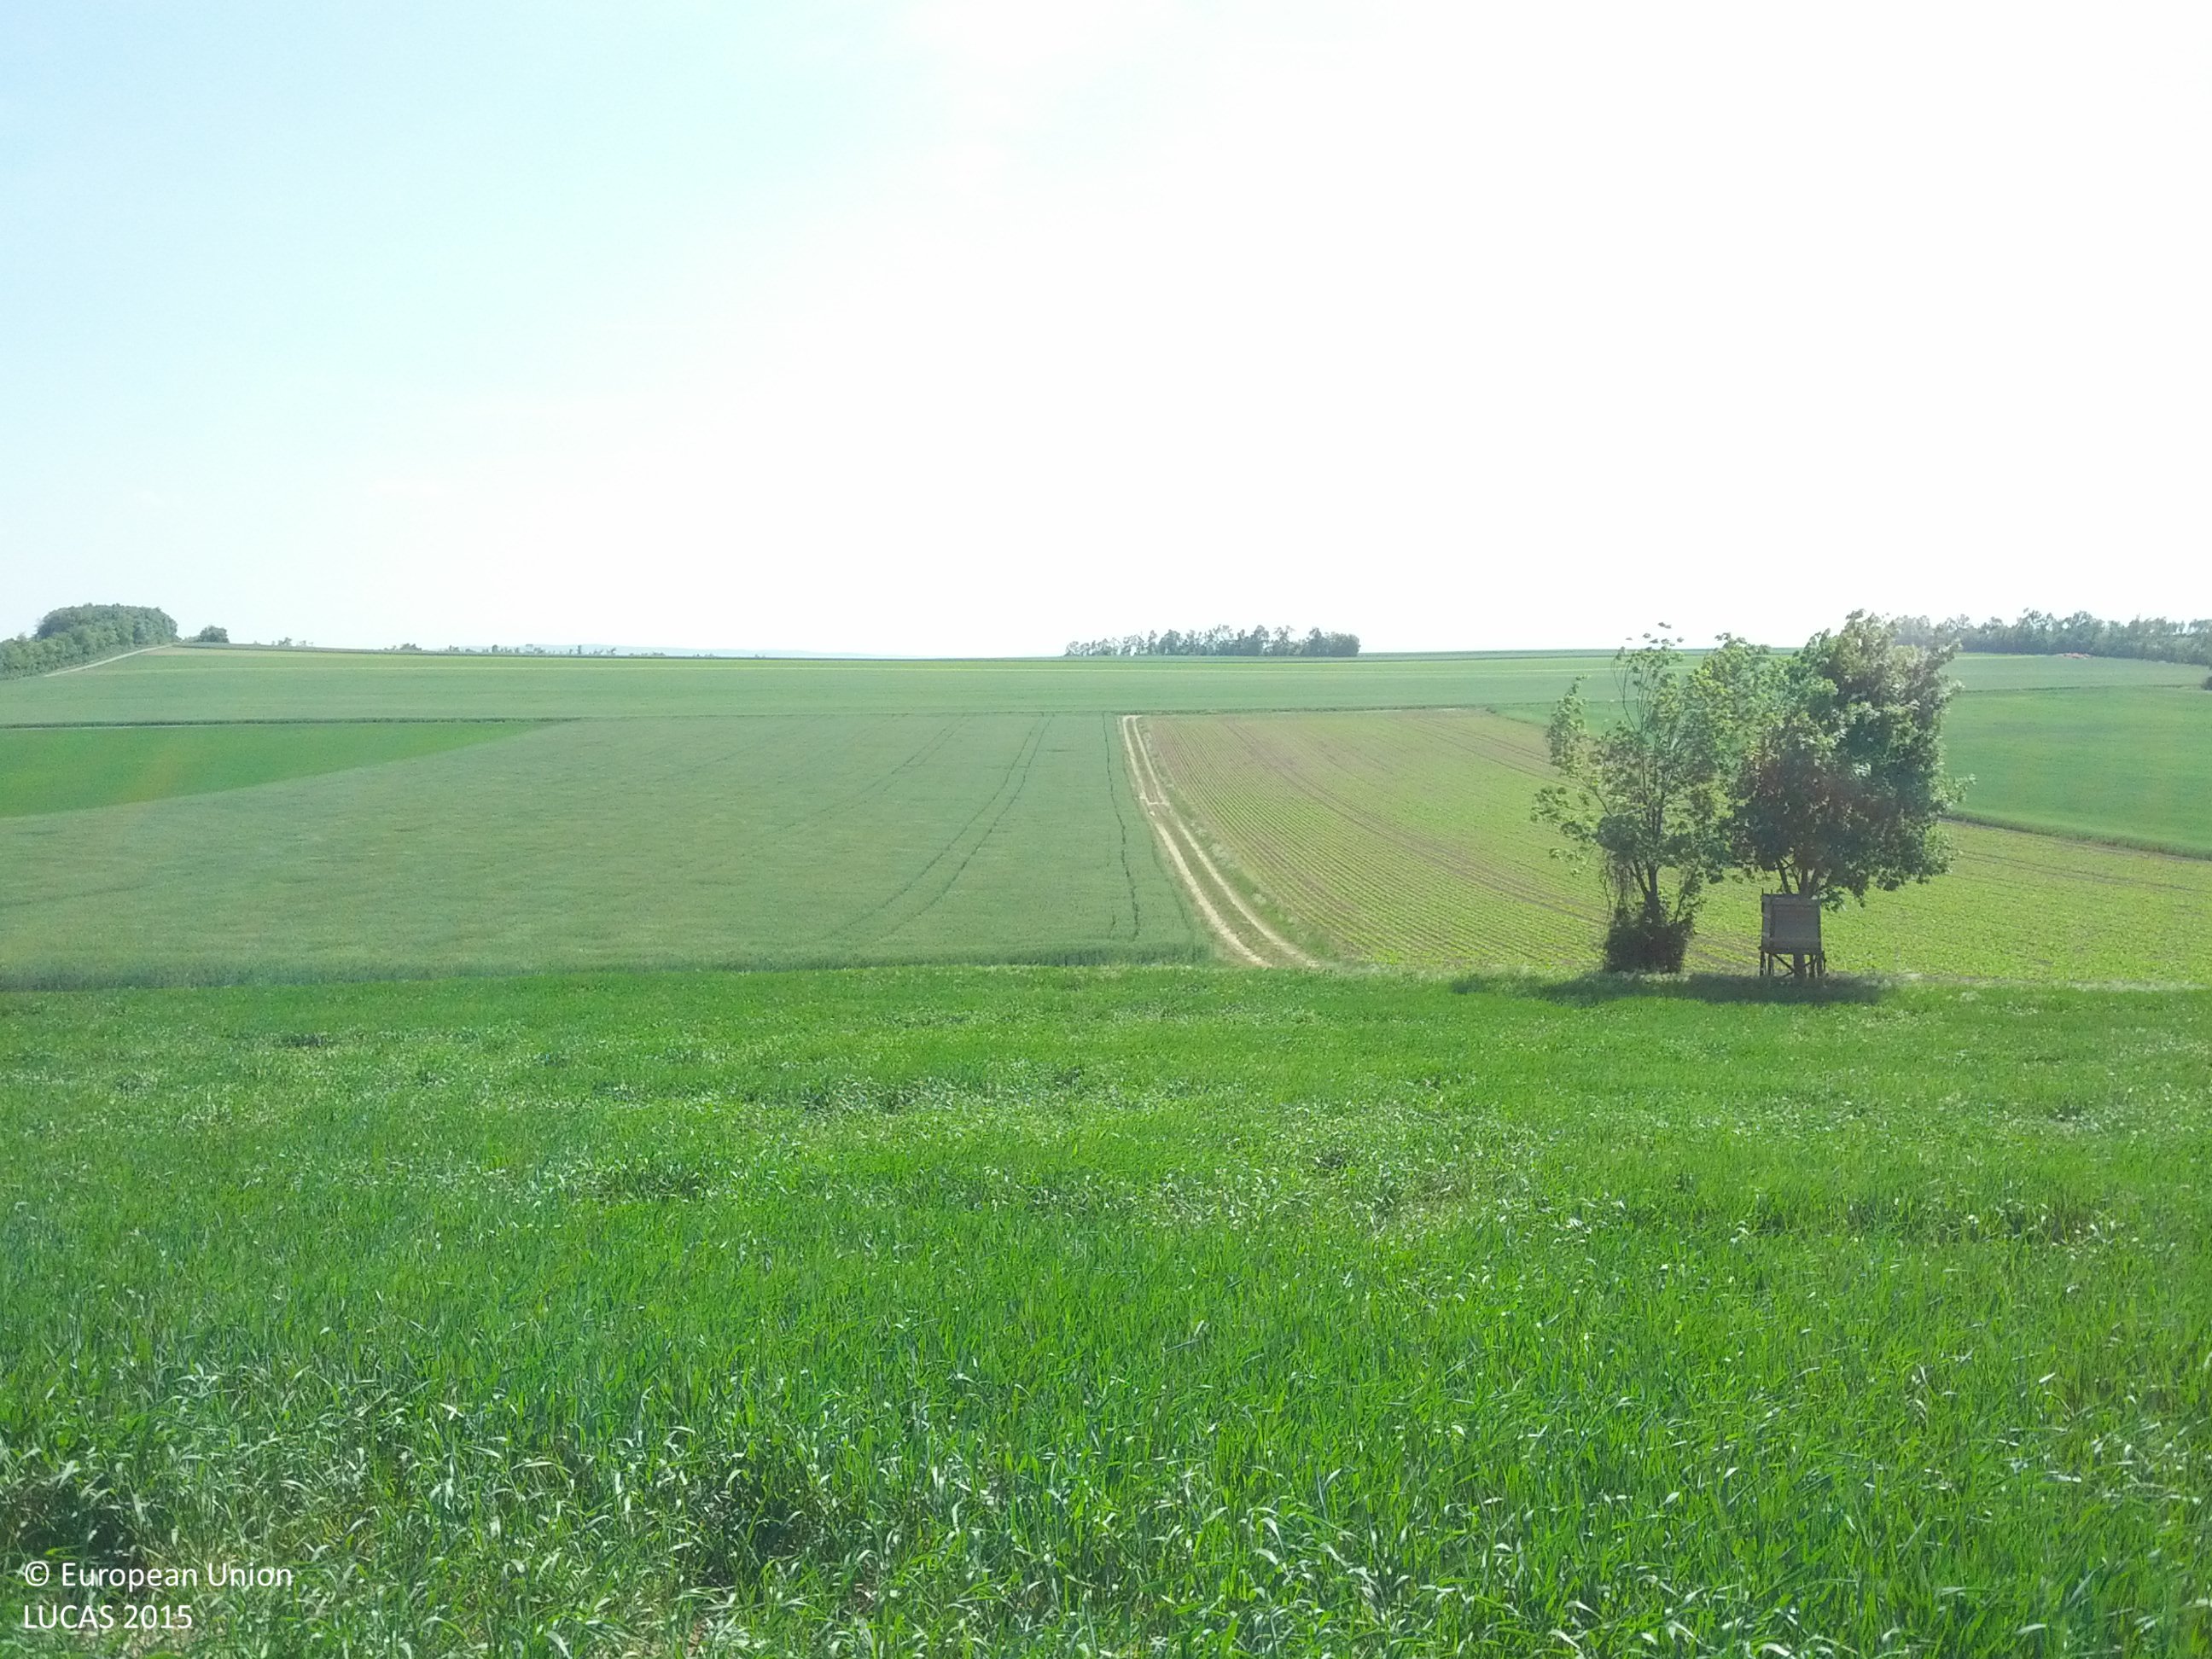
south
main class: Cropland
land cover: Barley
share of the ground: > 75 %
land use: Agriculture (excluding fallow land and kitchen gardens)
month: May
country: AT
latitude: 48.0769
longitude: 16.6499
